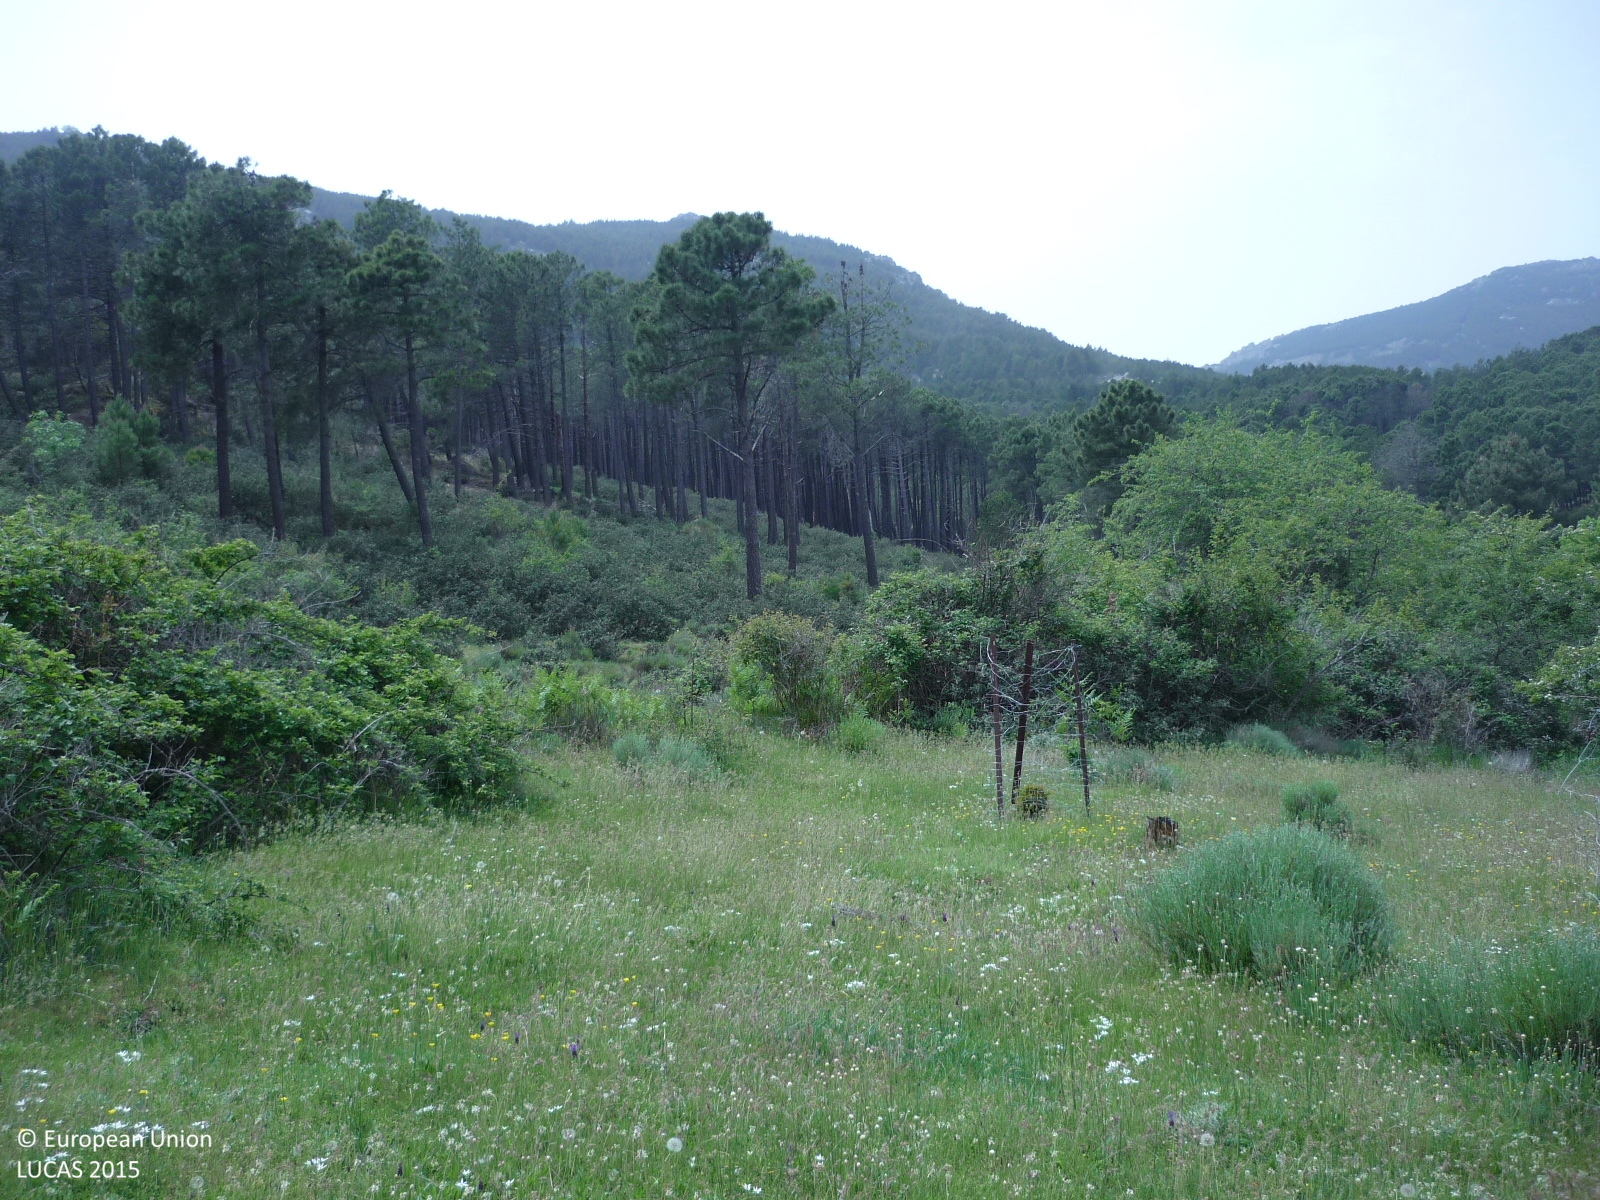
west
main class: Grassland
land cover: Grassland without tree/shrub cover
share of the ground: > 75 %
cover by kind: herbaceous plants 90 %, shrubs 5 %, unconsolidated bare surface 5 %
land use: Agriculture (excluding fallow land and kitchen gardens)
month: May
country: ES
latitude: 40.7546
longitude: -3.9149
